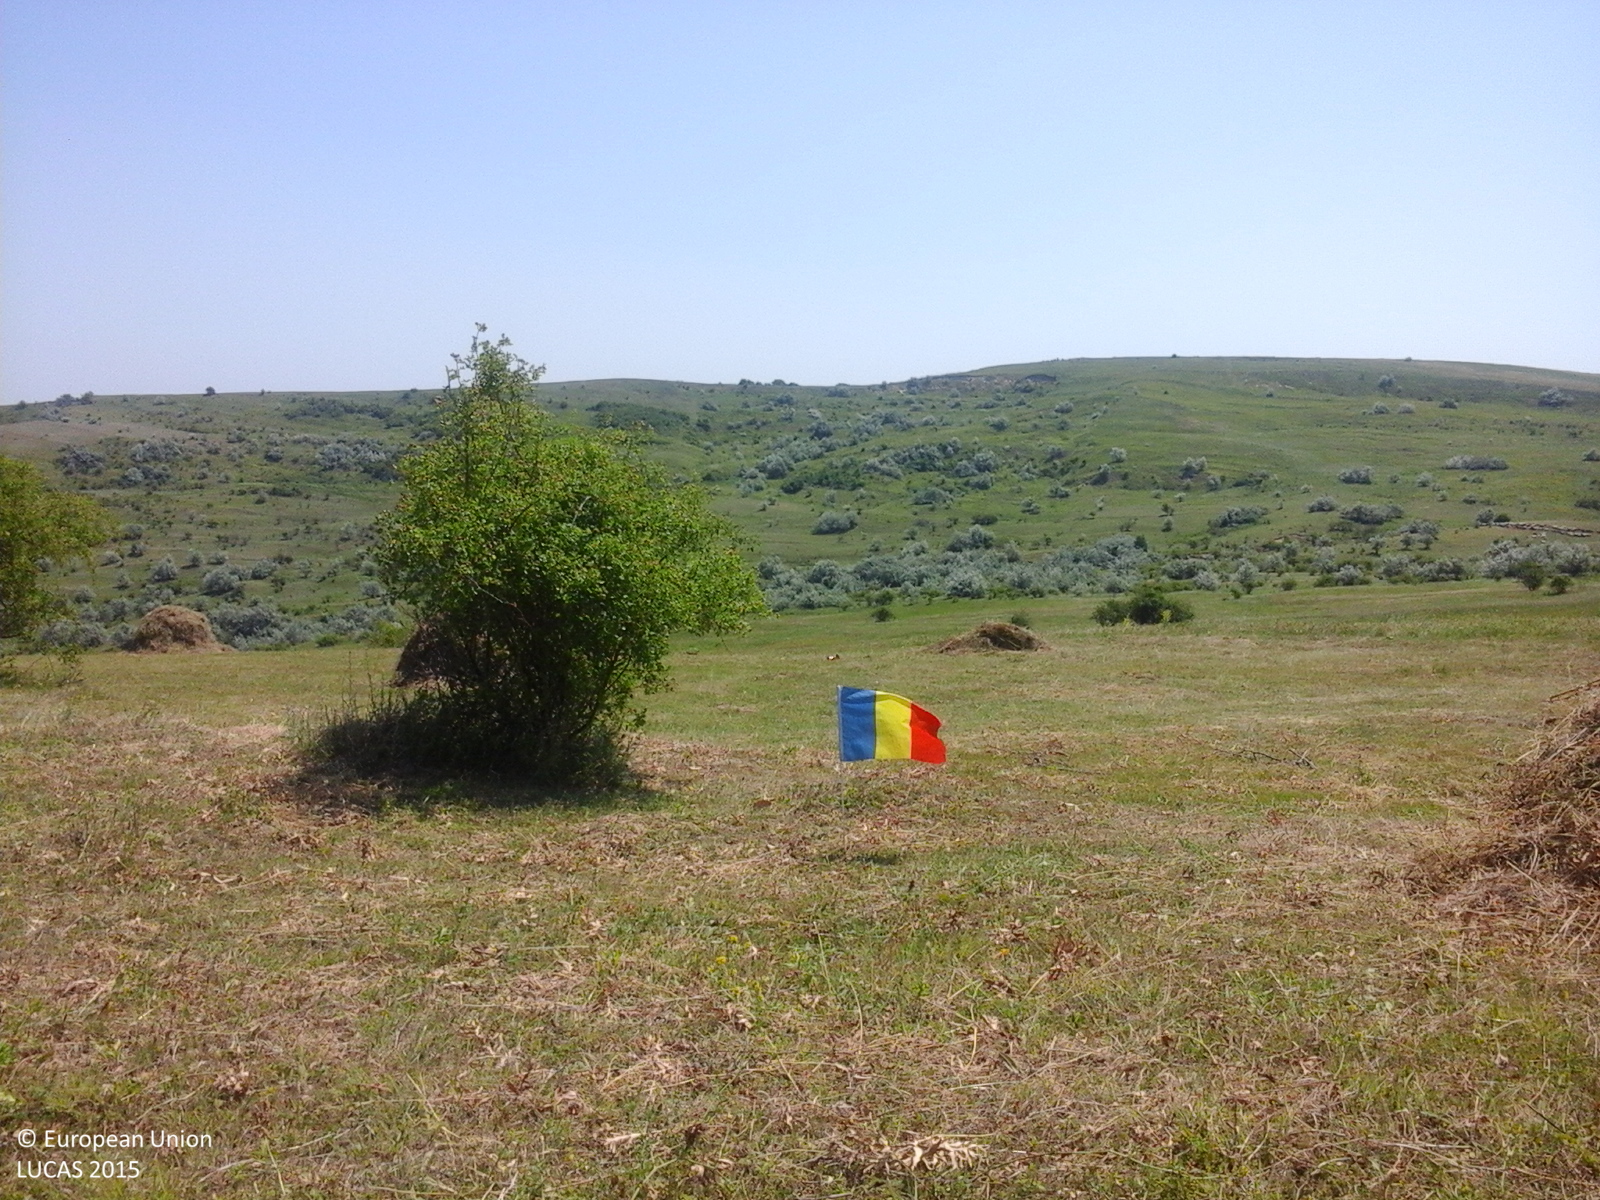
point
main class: Grassland
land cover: Grassland with sparse tree/shrub cover
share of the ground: > 75 %
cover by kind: herbaceous plants 90 %, broadleaved forest trees 5 %, shrubs 5 %
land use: Agriculture (excluding fallow land and kitchen gardens)
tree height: < 5 m
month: June
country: RO
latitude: 46.7429
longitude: 27.4536
